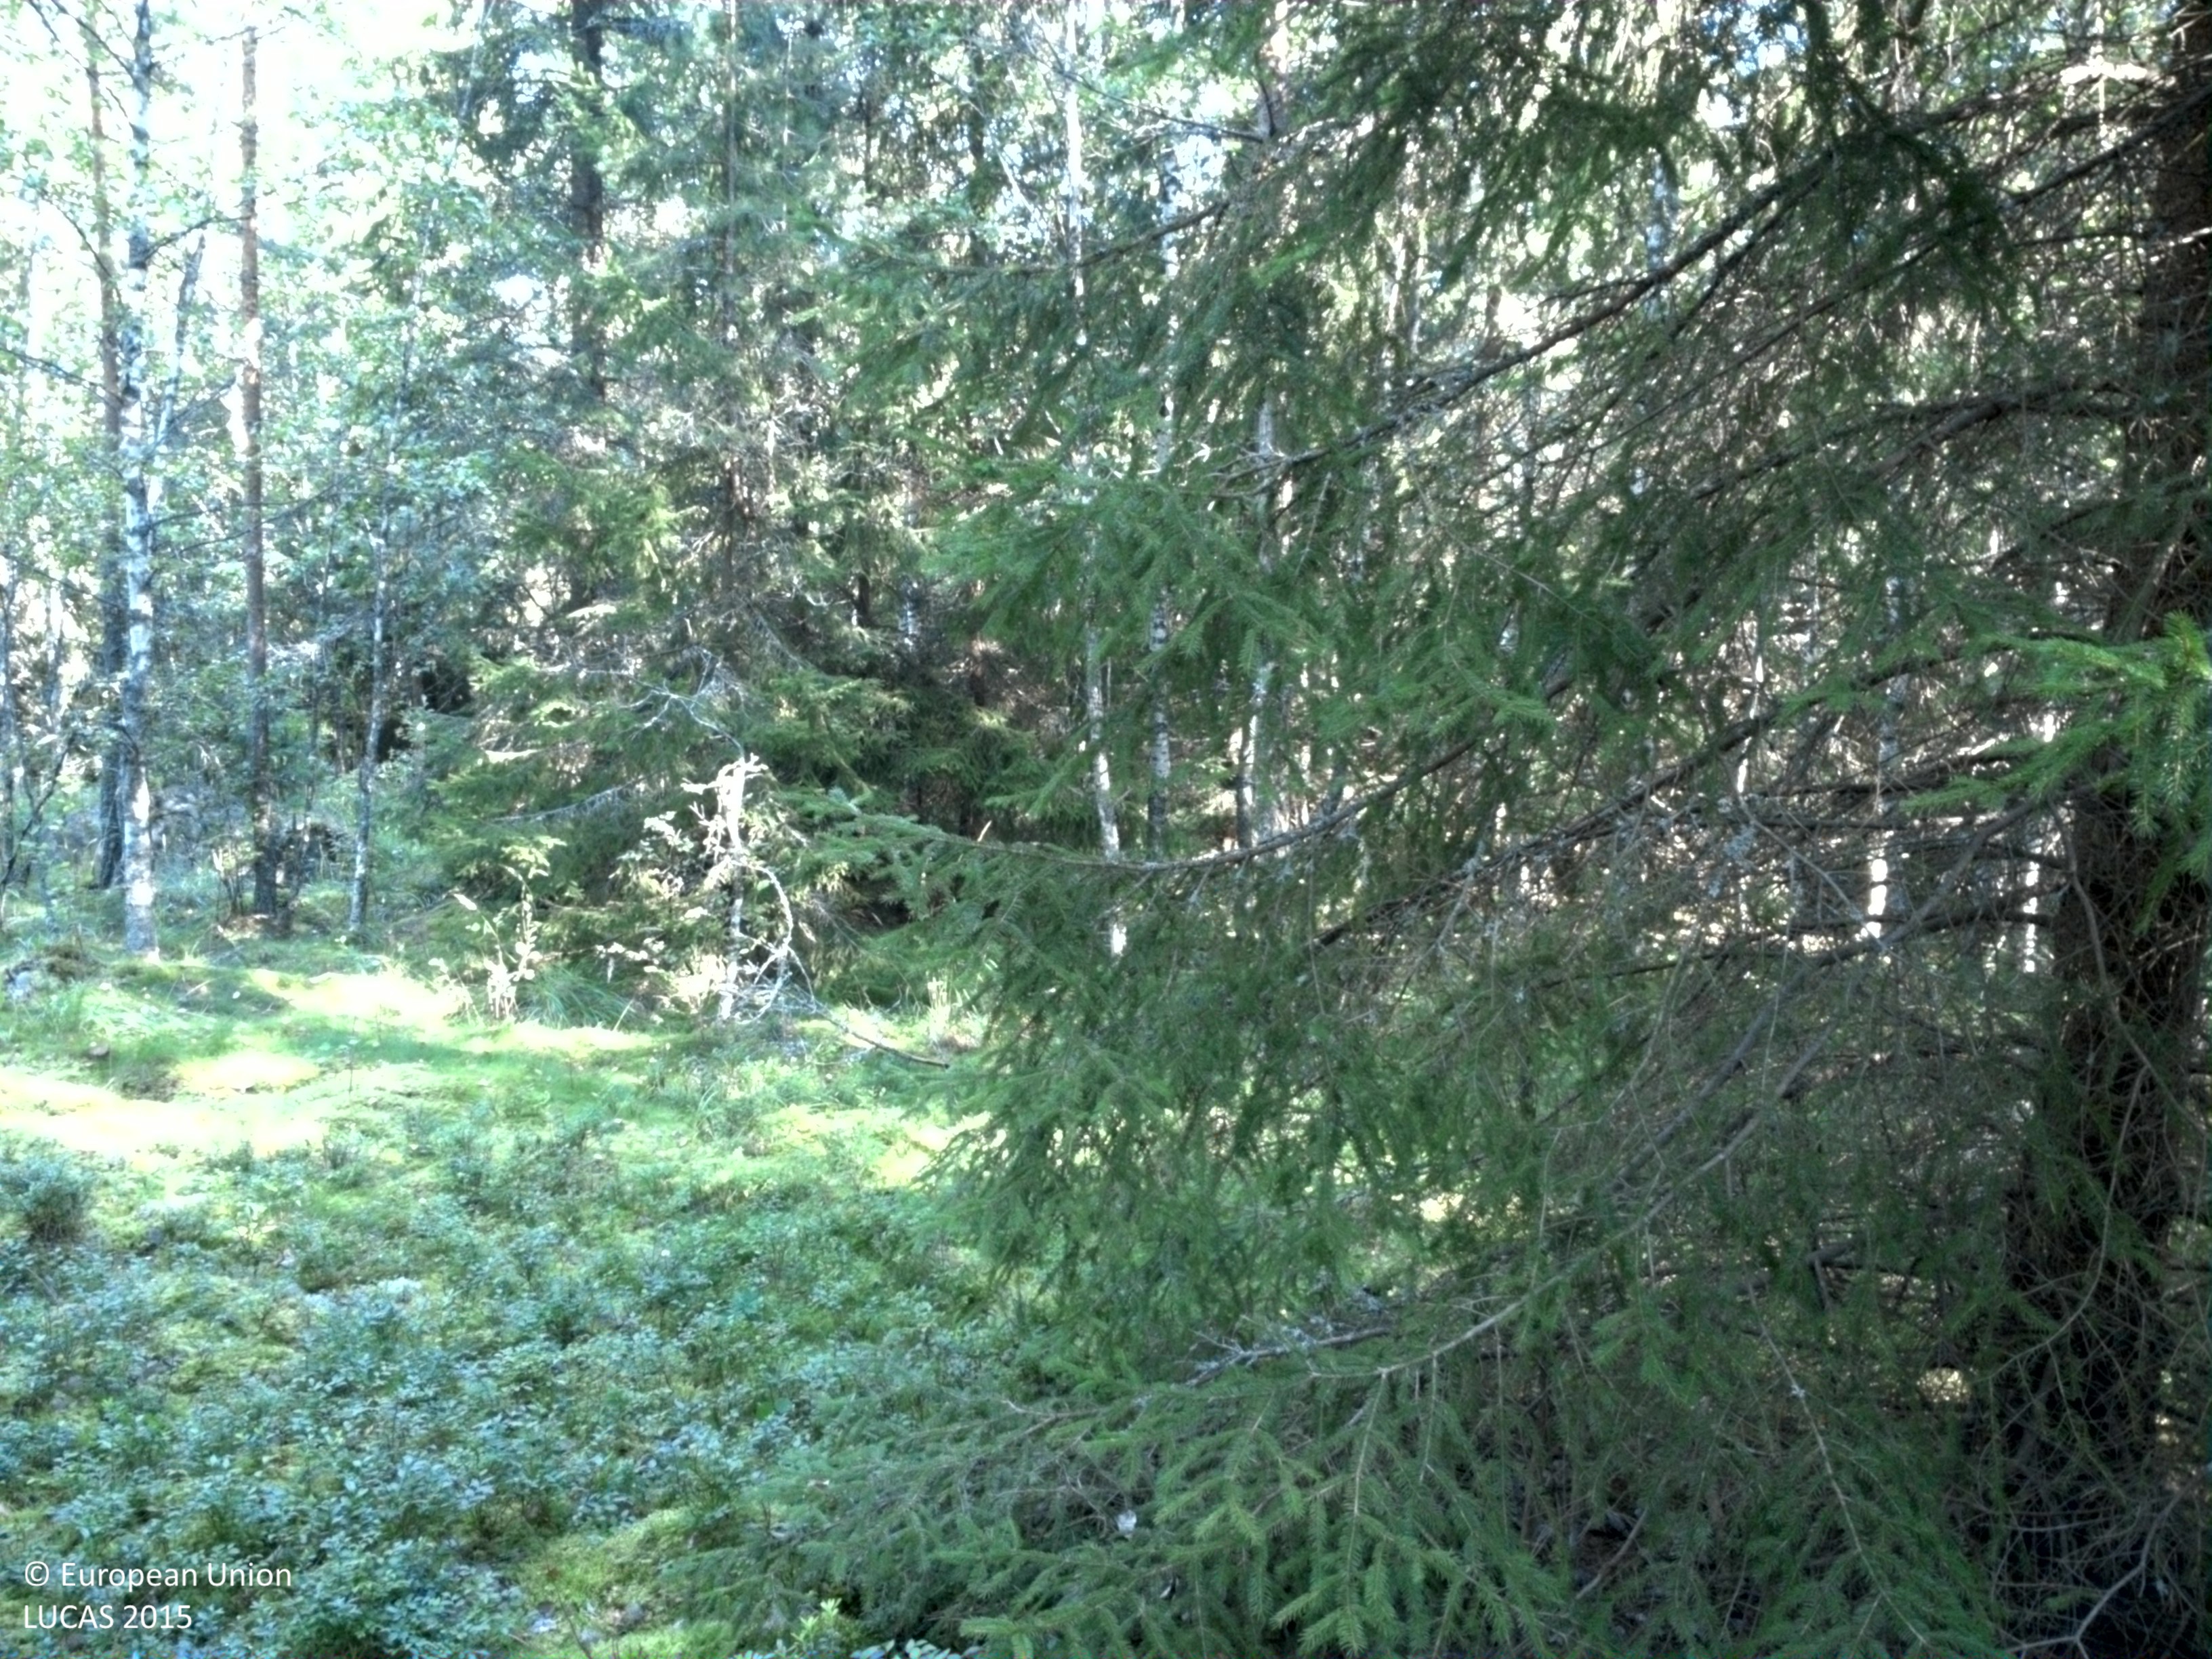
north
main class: Woodland
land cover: Spruce dominated mixed woodland
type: boreal forest
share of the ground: 50 - 75 %
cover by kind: coniferous forest trees 50 %, lichens and mosses 30 %, broadleaved forest trees 20 %
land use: Forestry
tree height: > 5 m
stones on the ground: 10 - 25 %
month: August
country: SE
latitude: 59.7812
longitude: 17.1716
